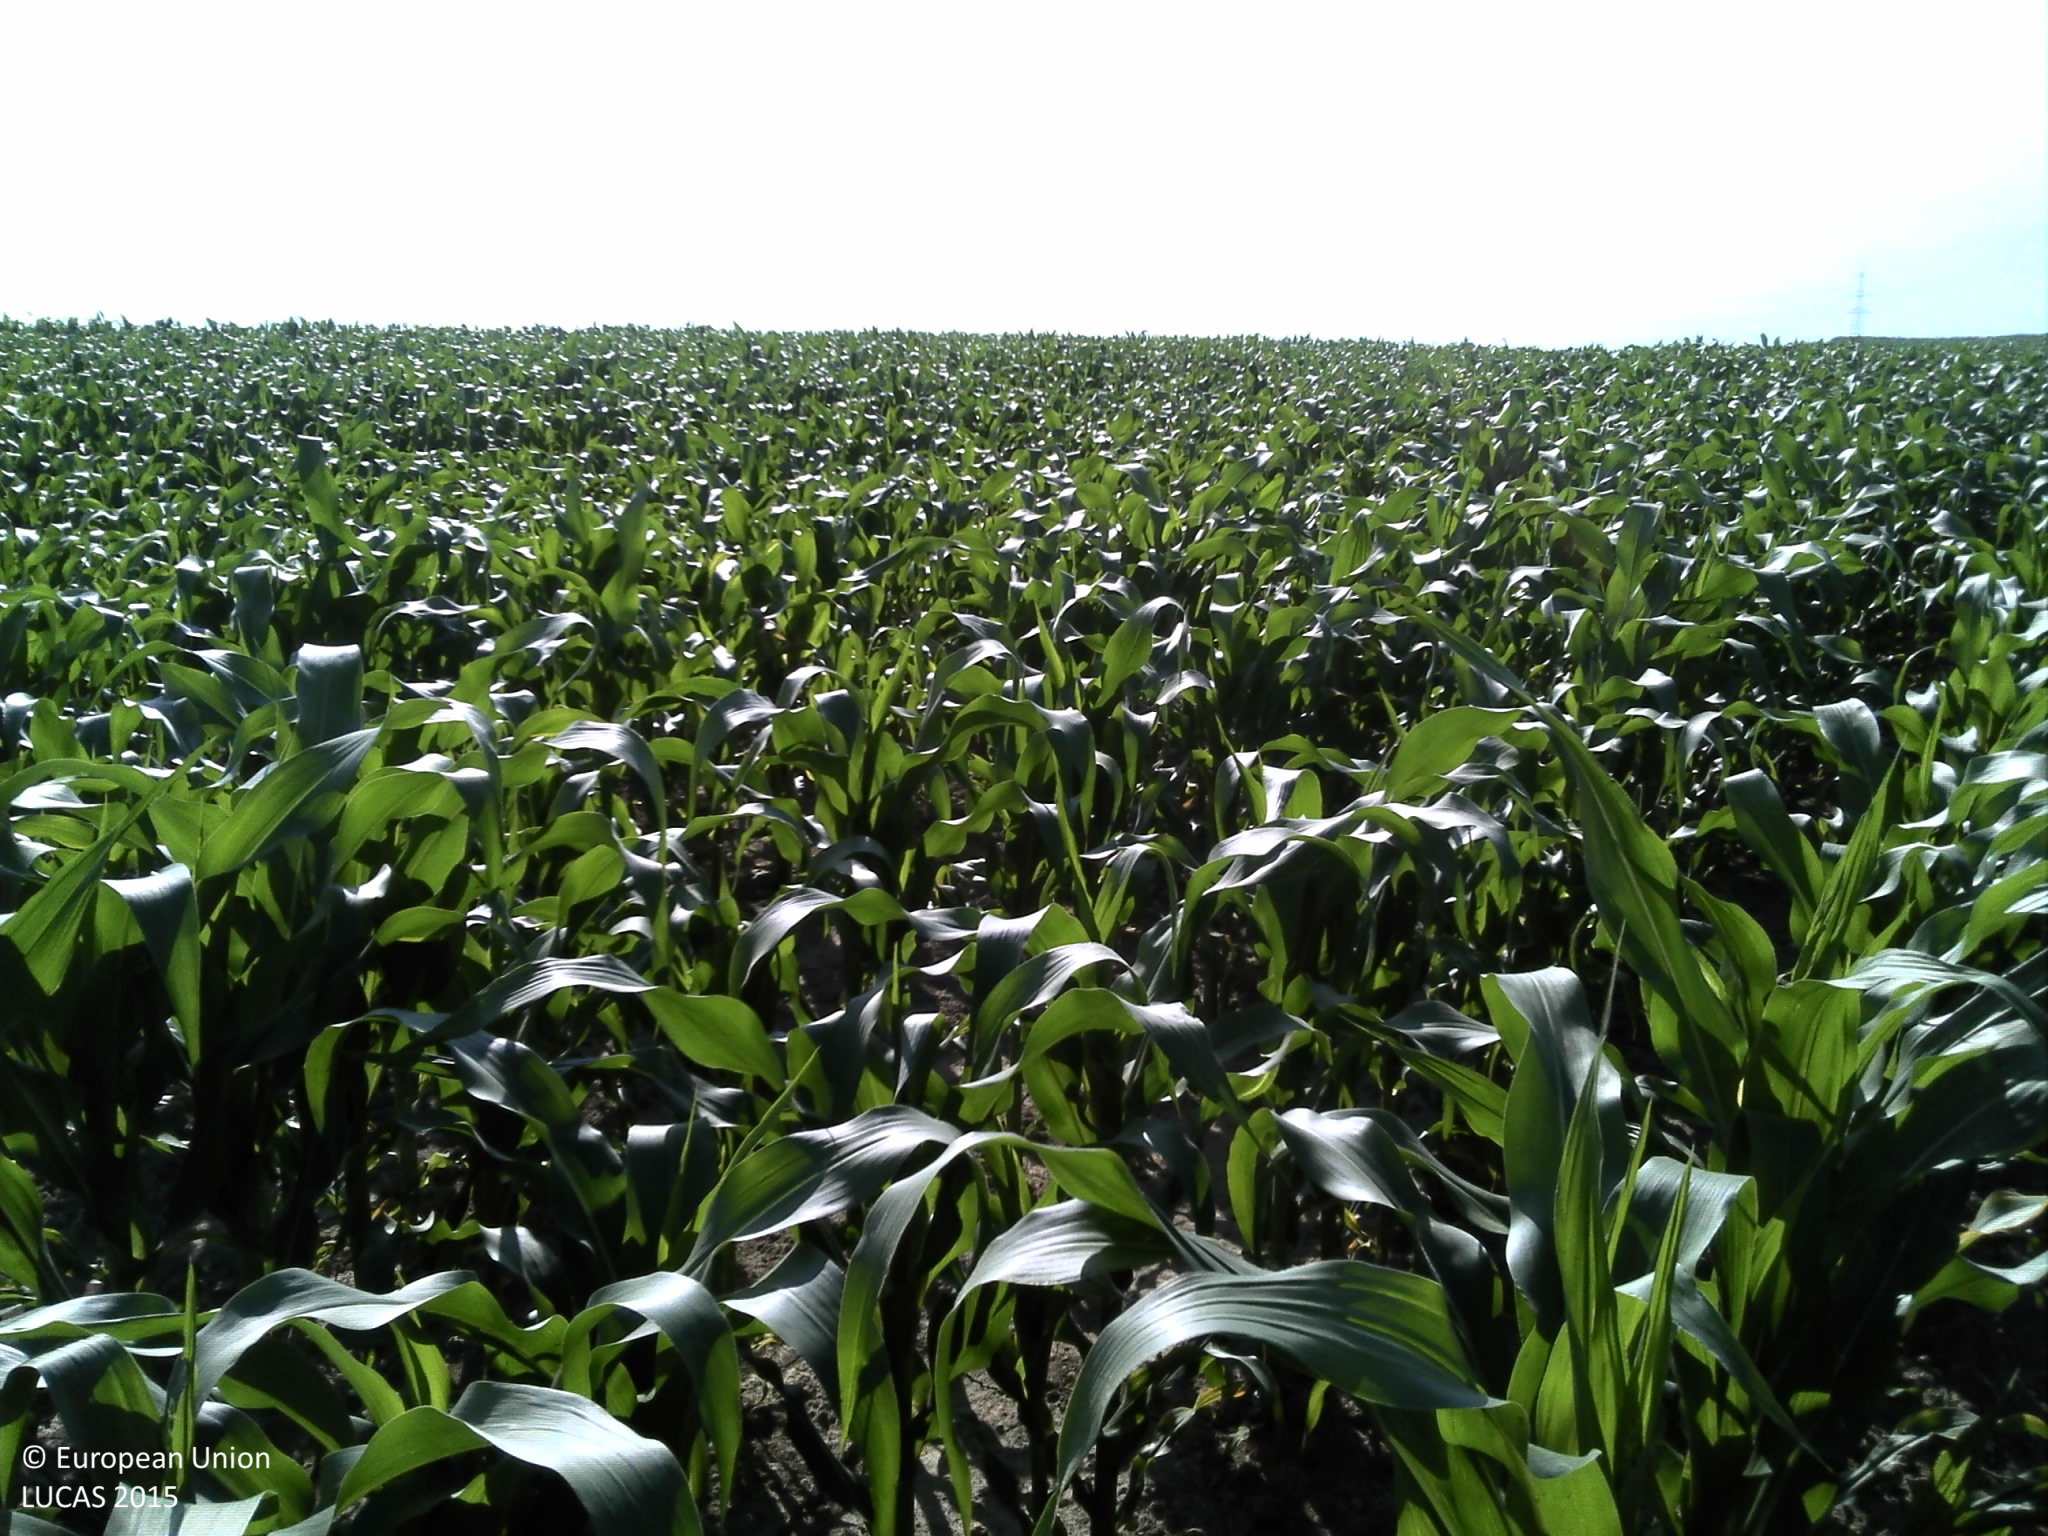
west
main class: Cropland
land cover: Maize
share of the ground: > 75 %
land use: Agriculture (excluding fallow land and kitchen gardens)
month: June
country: HR
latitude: 45.7364
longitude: 18.5539
